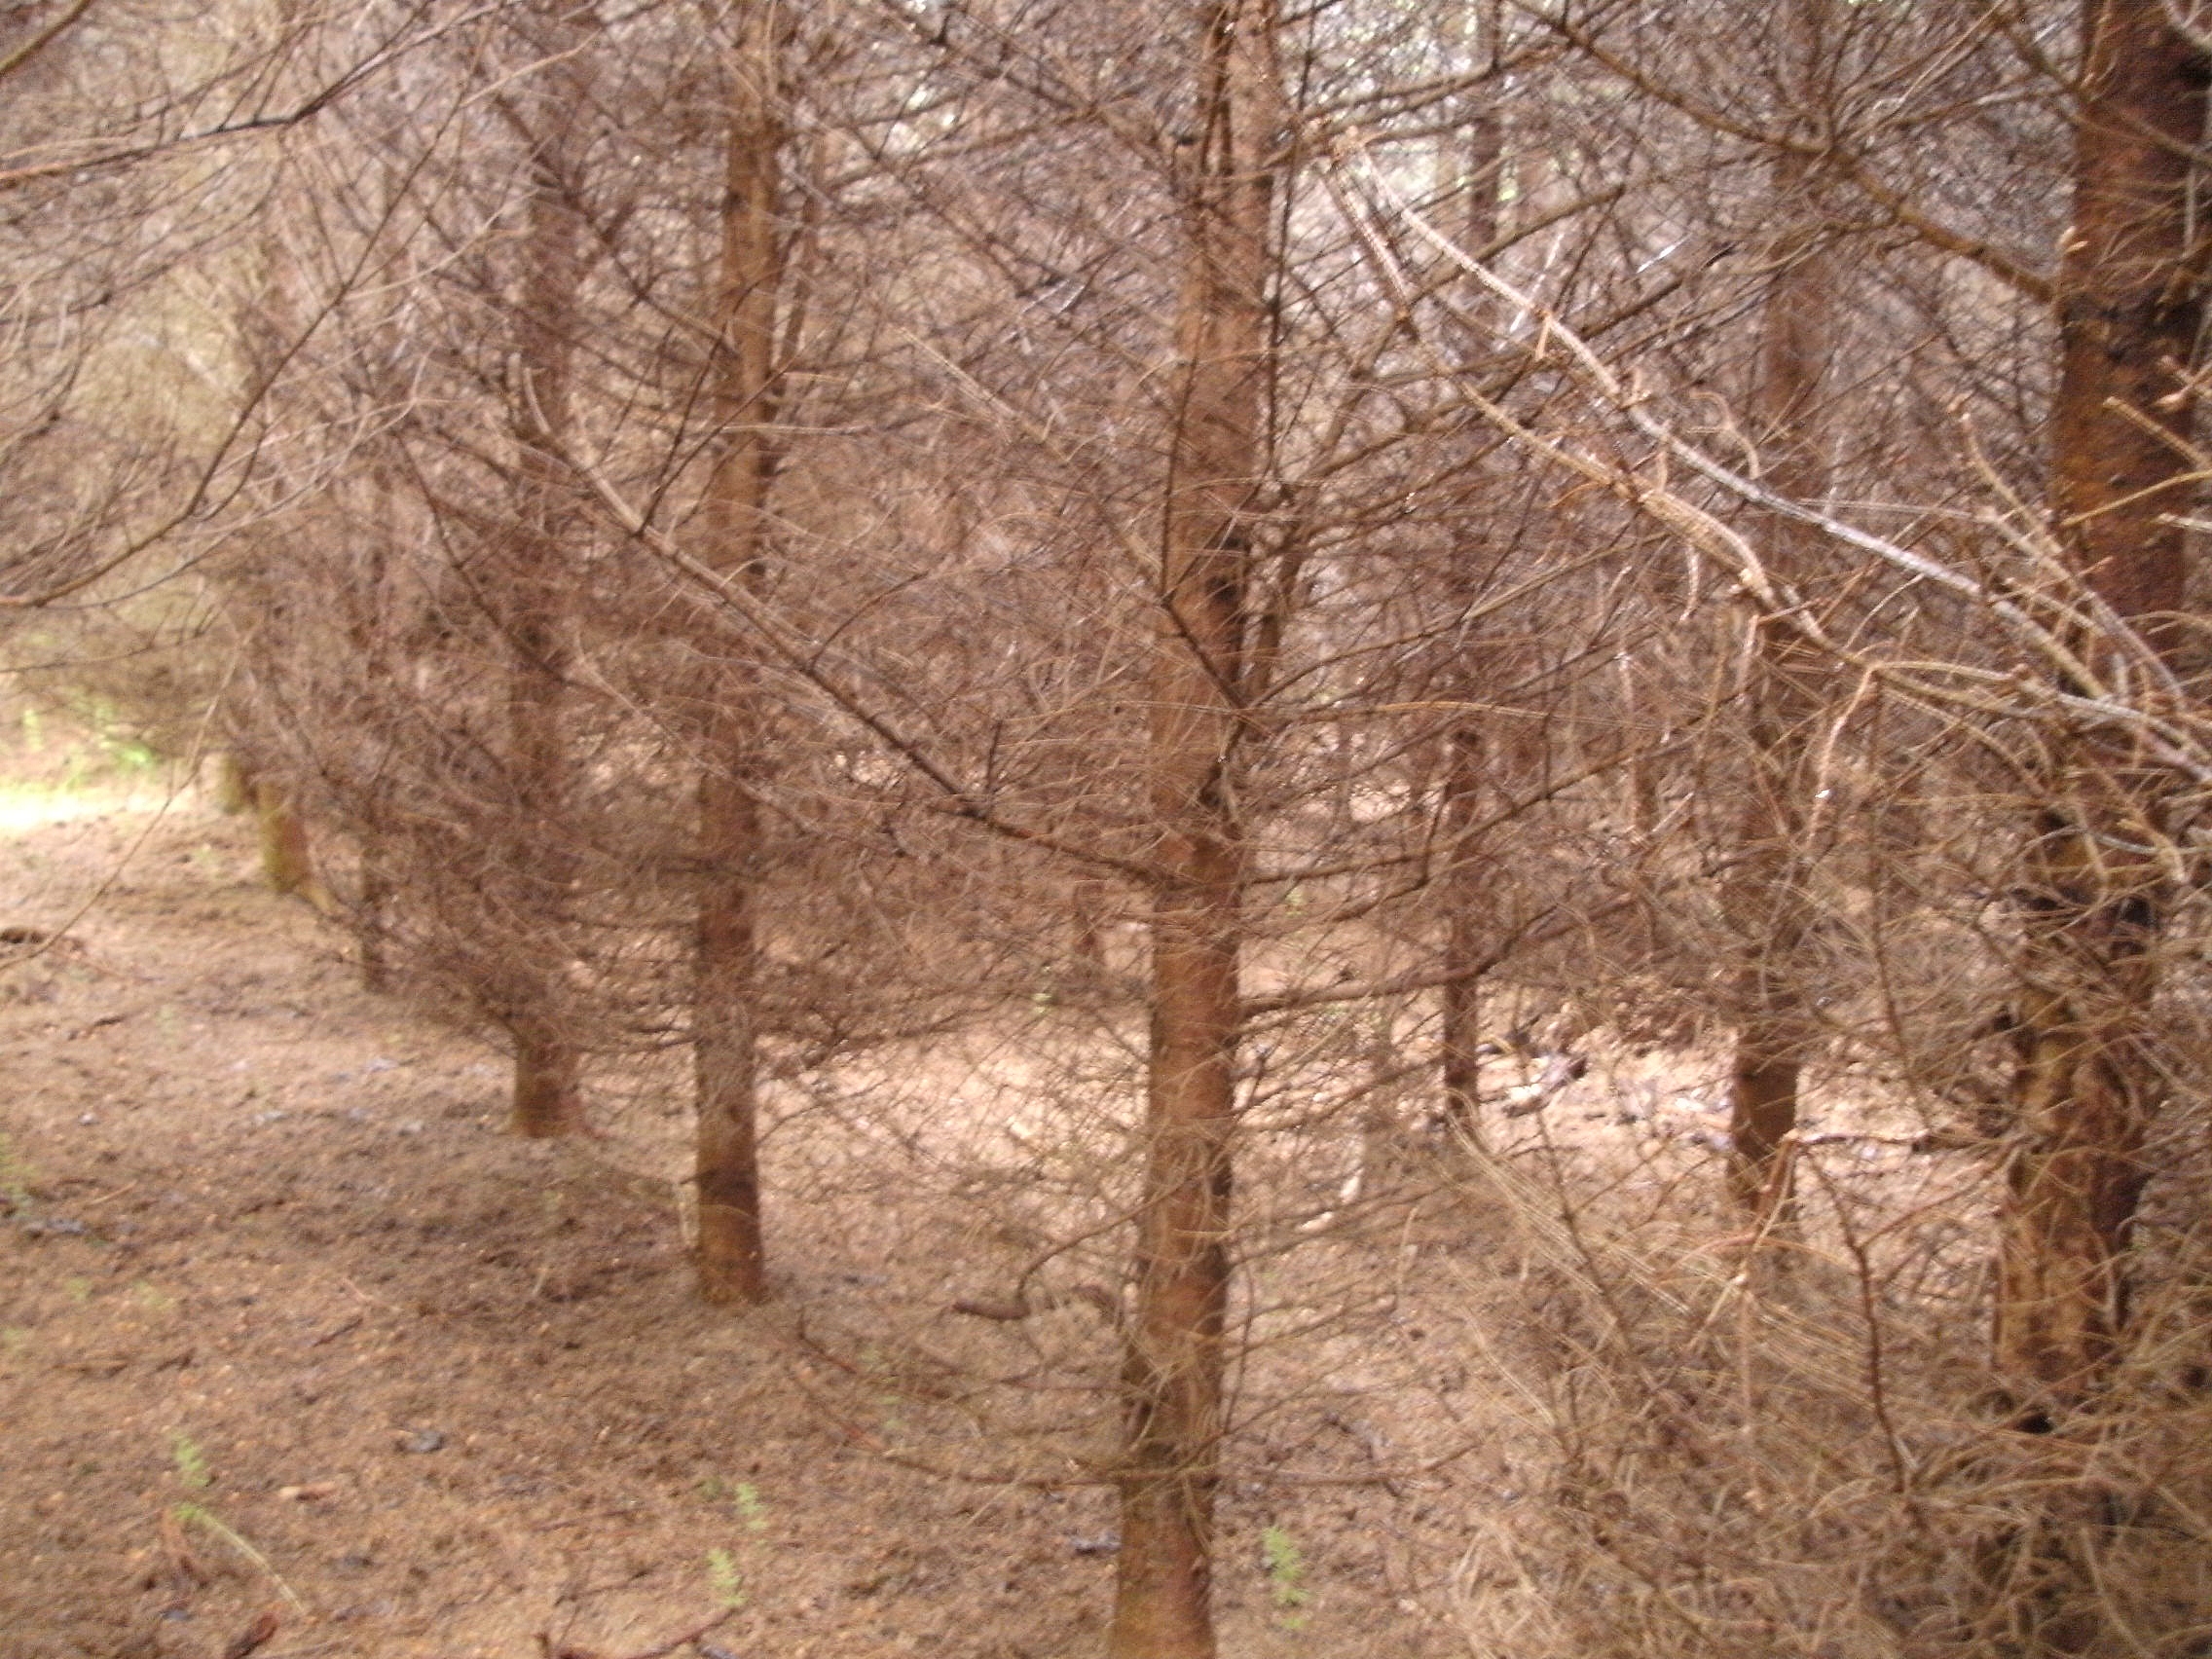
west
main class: Woodland
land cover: Spruce dominated coniferous woodland
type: hemiboreal forest and nemoral coniferous forest and mixed broadleaved-coniferous forest
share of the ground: > 75 %
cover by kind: coniferous forest trees 95 %, unconsolidated bare surface 5 %
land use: Forestry
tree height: > 5 m
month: May
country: AT
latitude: 48.4031
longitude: 13.4710
